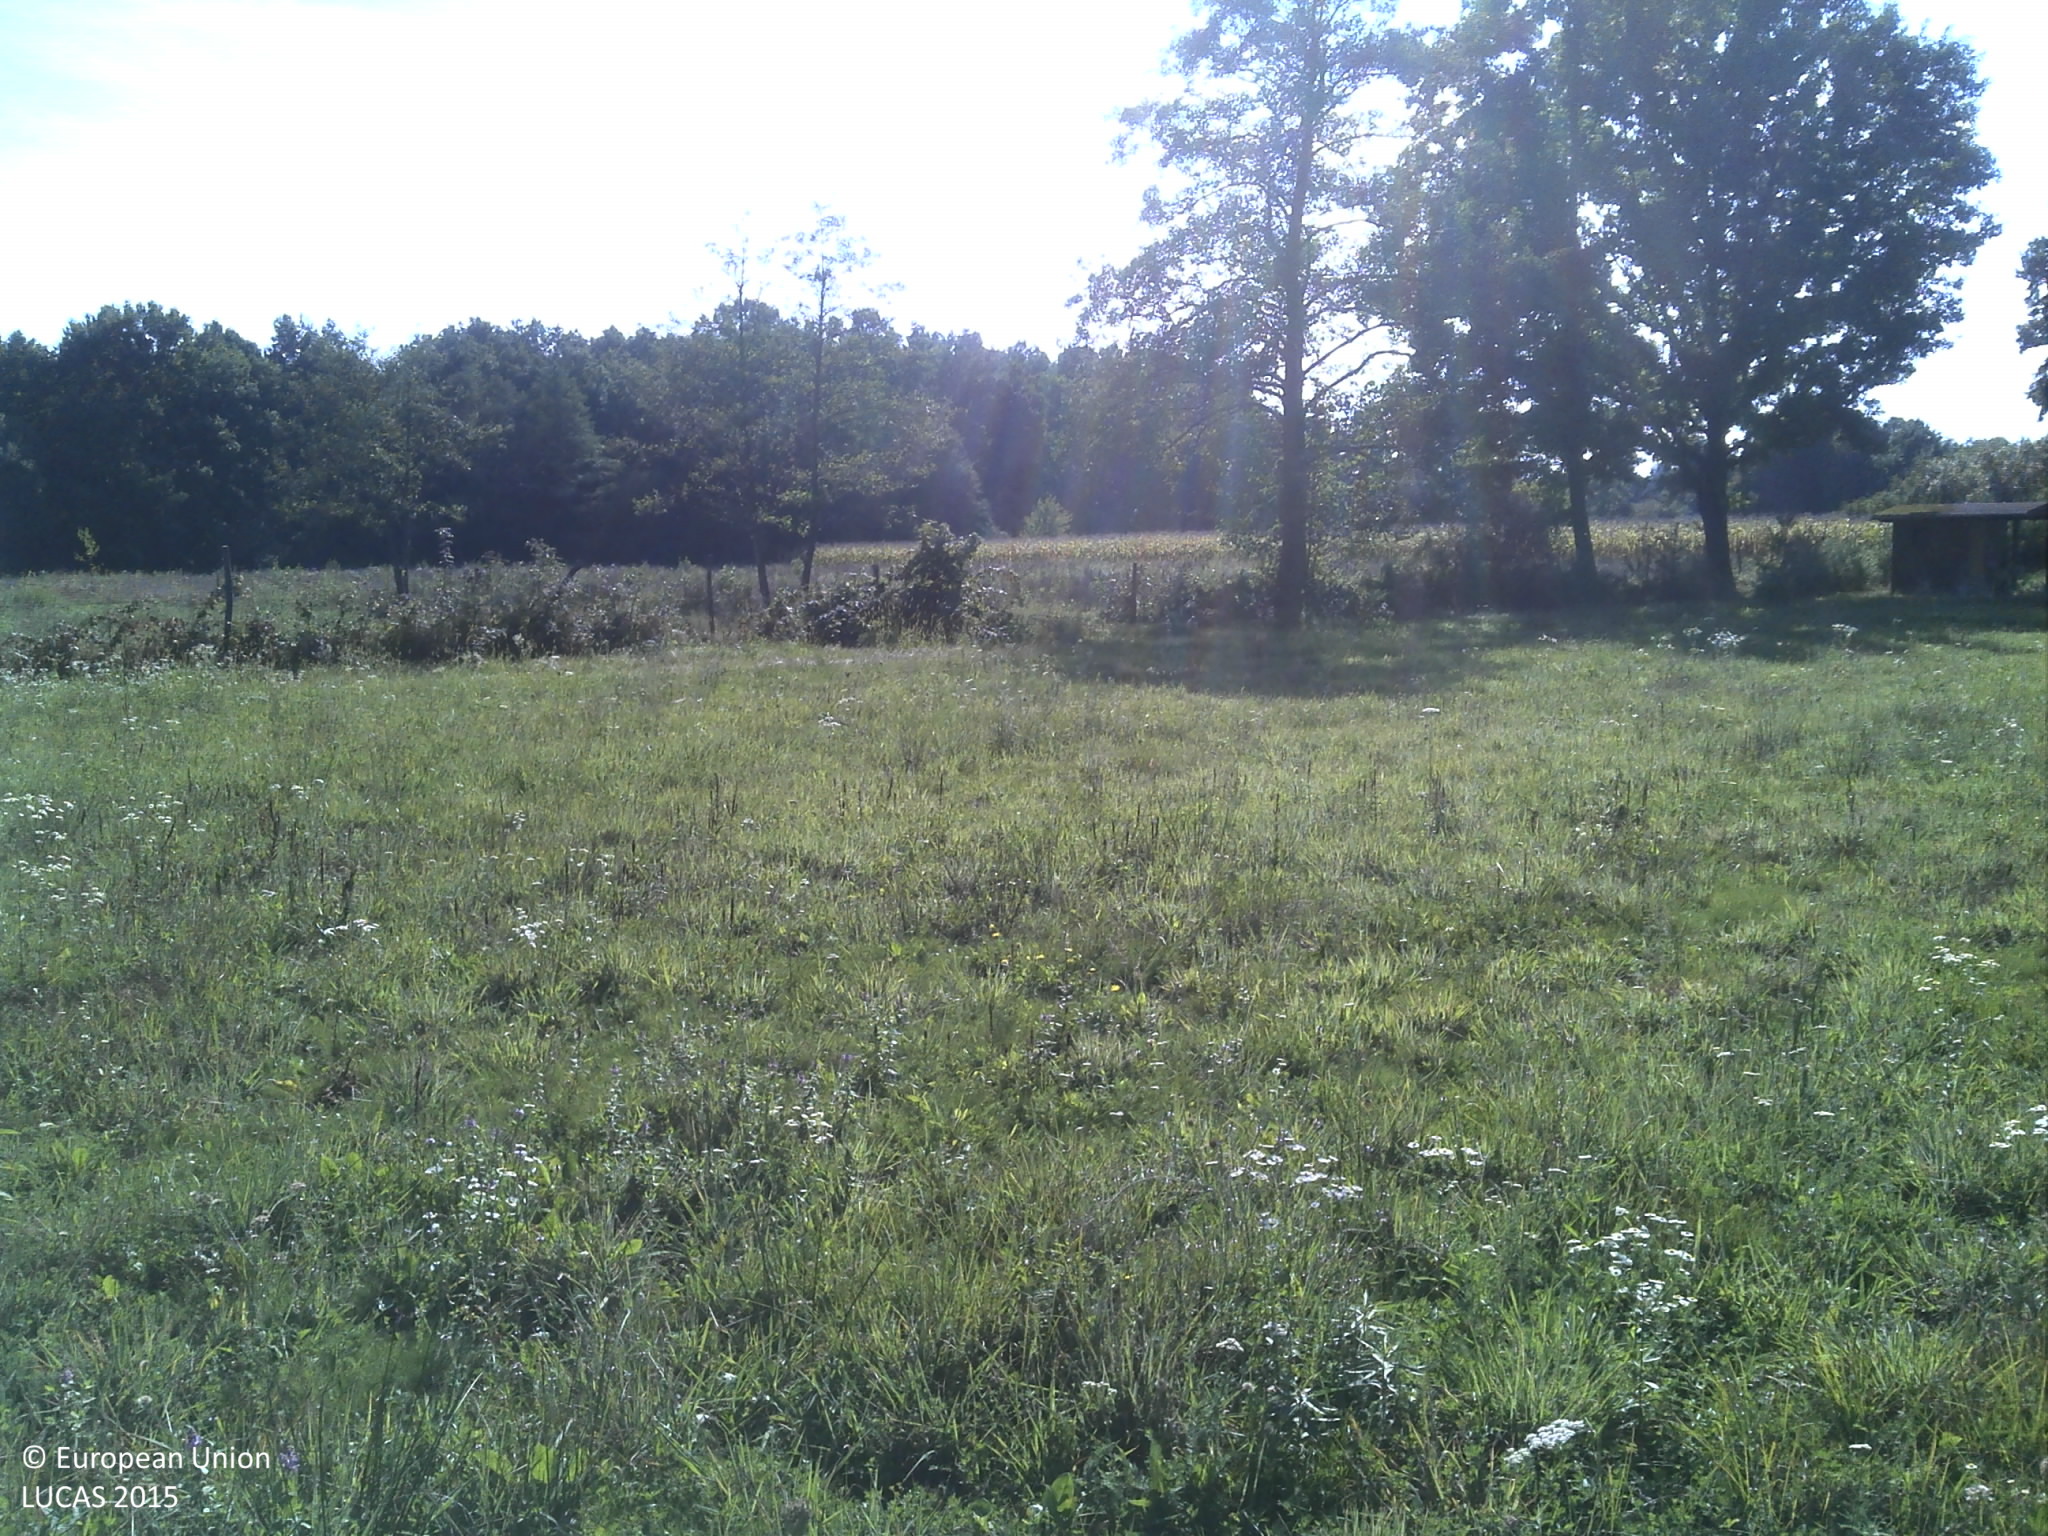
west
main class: Grassland
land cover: Grassland without tree/shrub cover
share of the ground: > 75 %
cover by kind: herbaceous plants 100 %
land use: Semi-natural and natural areas not in use
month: September
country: HR
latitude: 45.4816
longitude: 16.2535
